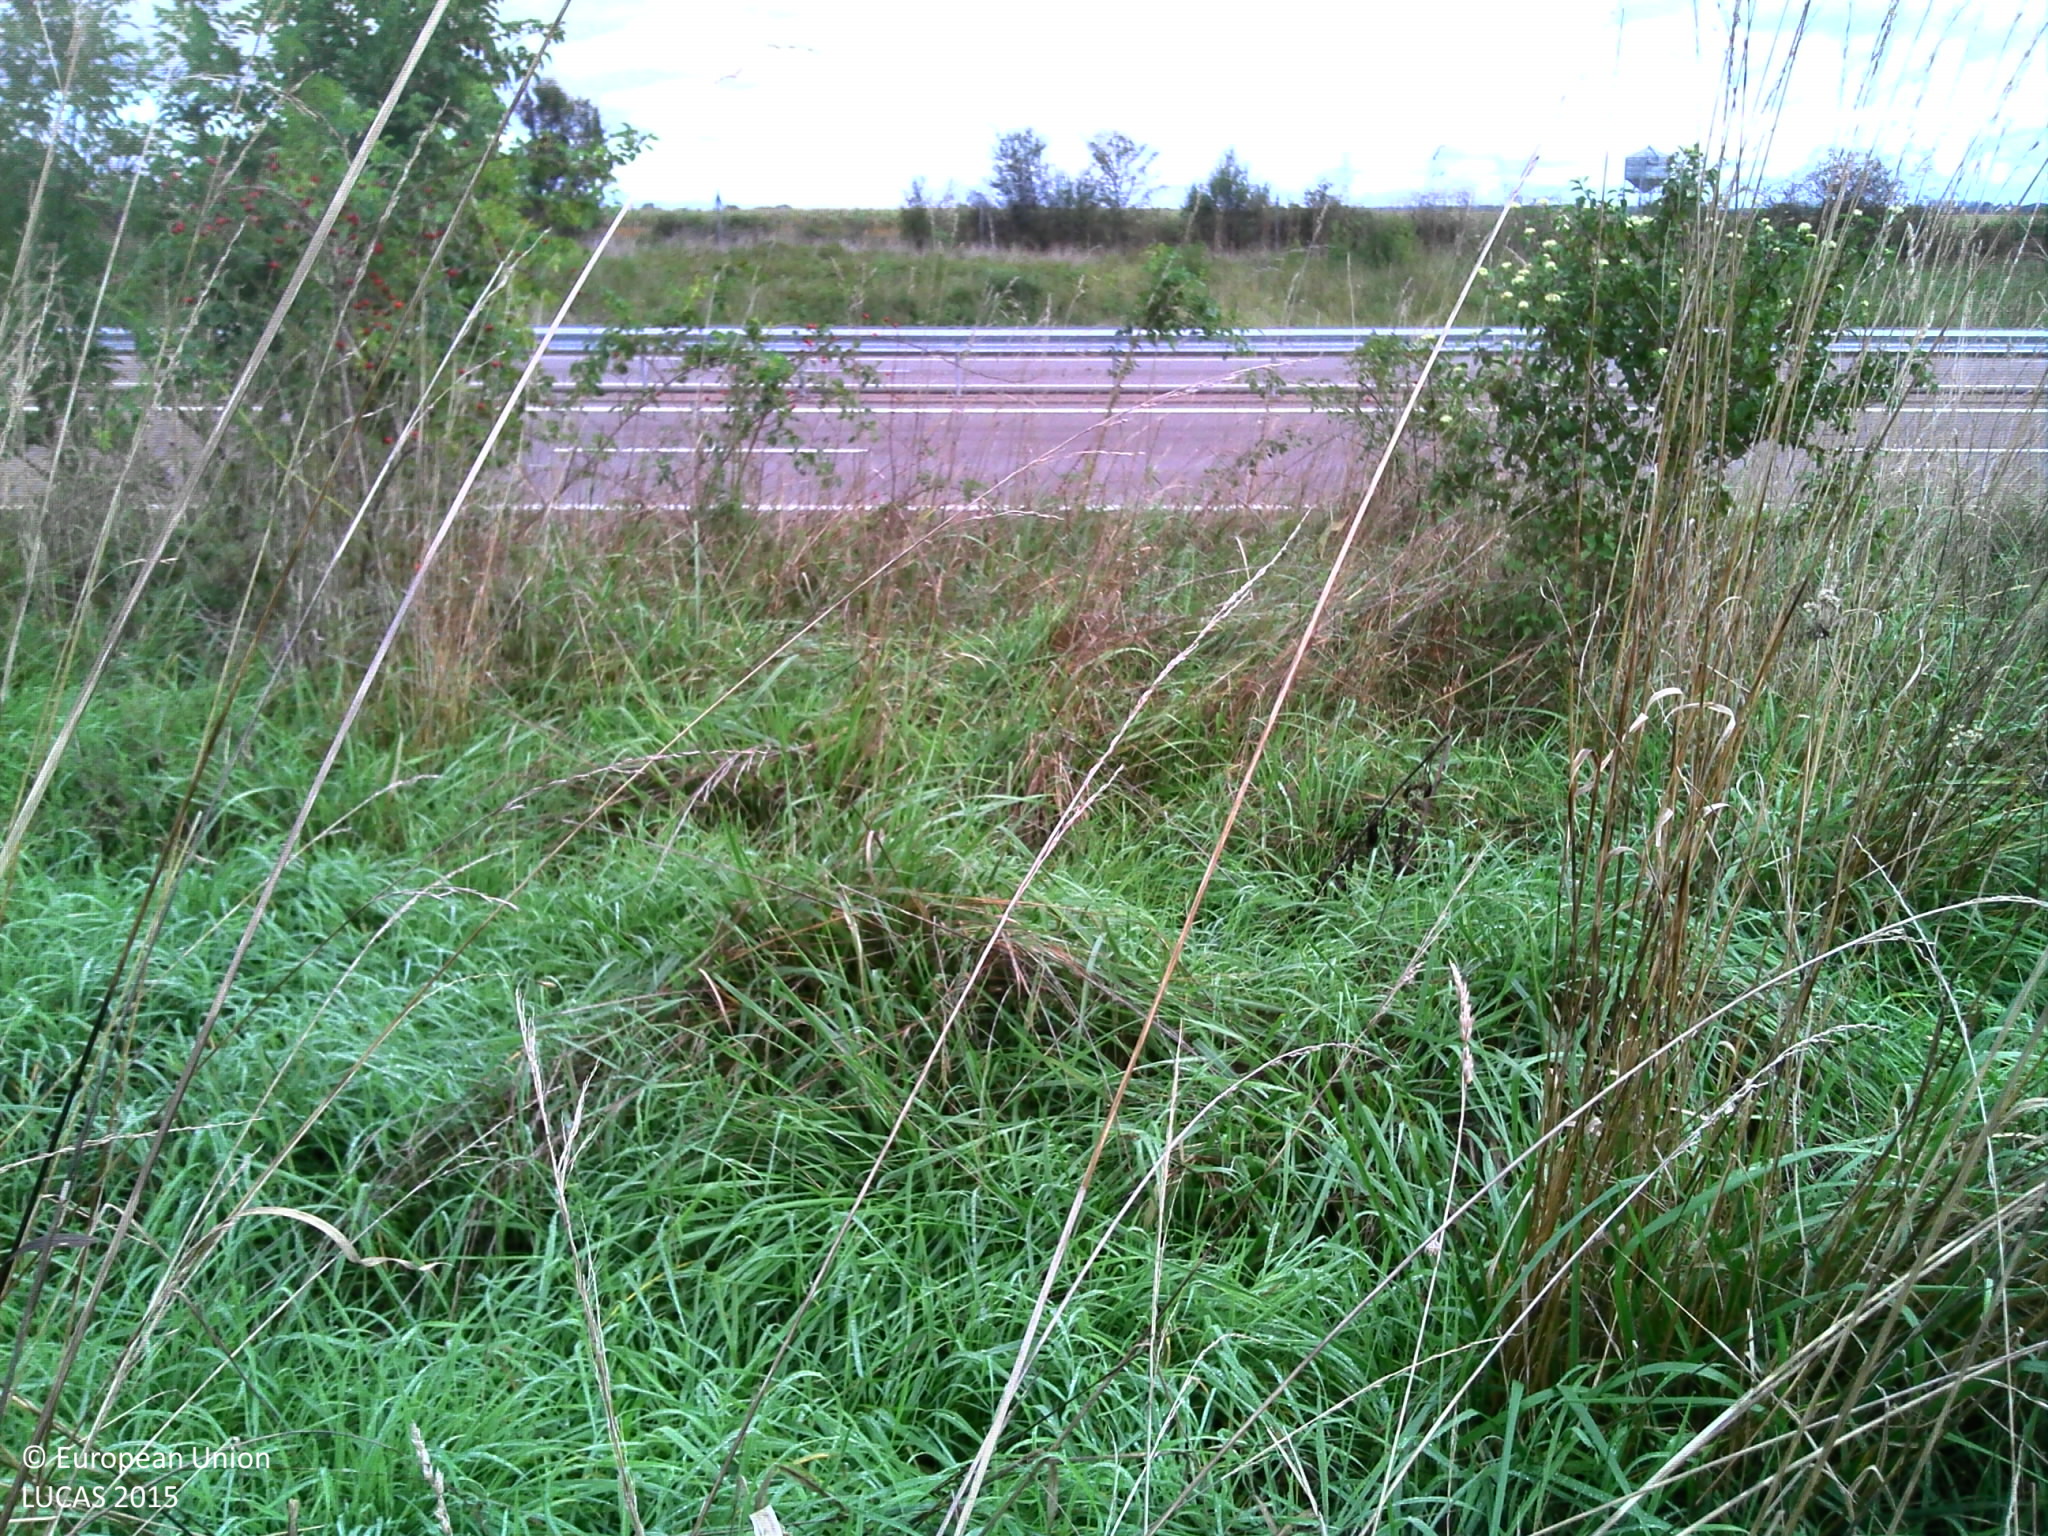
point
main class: Grassland
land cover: Grassland without tree/shrub cover
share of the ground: > 75 %
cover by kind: herbaceous plants 95 %, shrubs 5 %
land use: Road transport
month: September
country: FR
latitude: 47.0455
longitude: 4.9861
